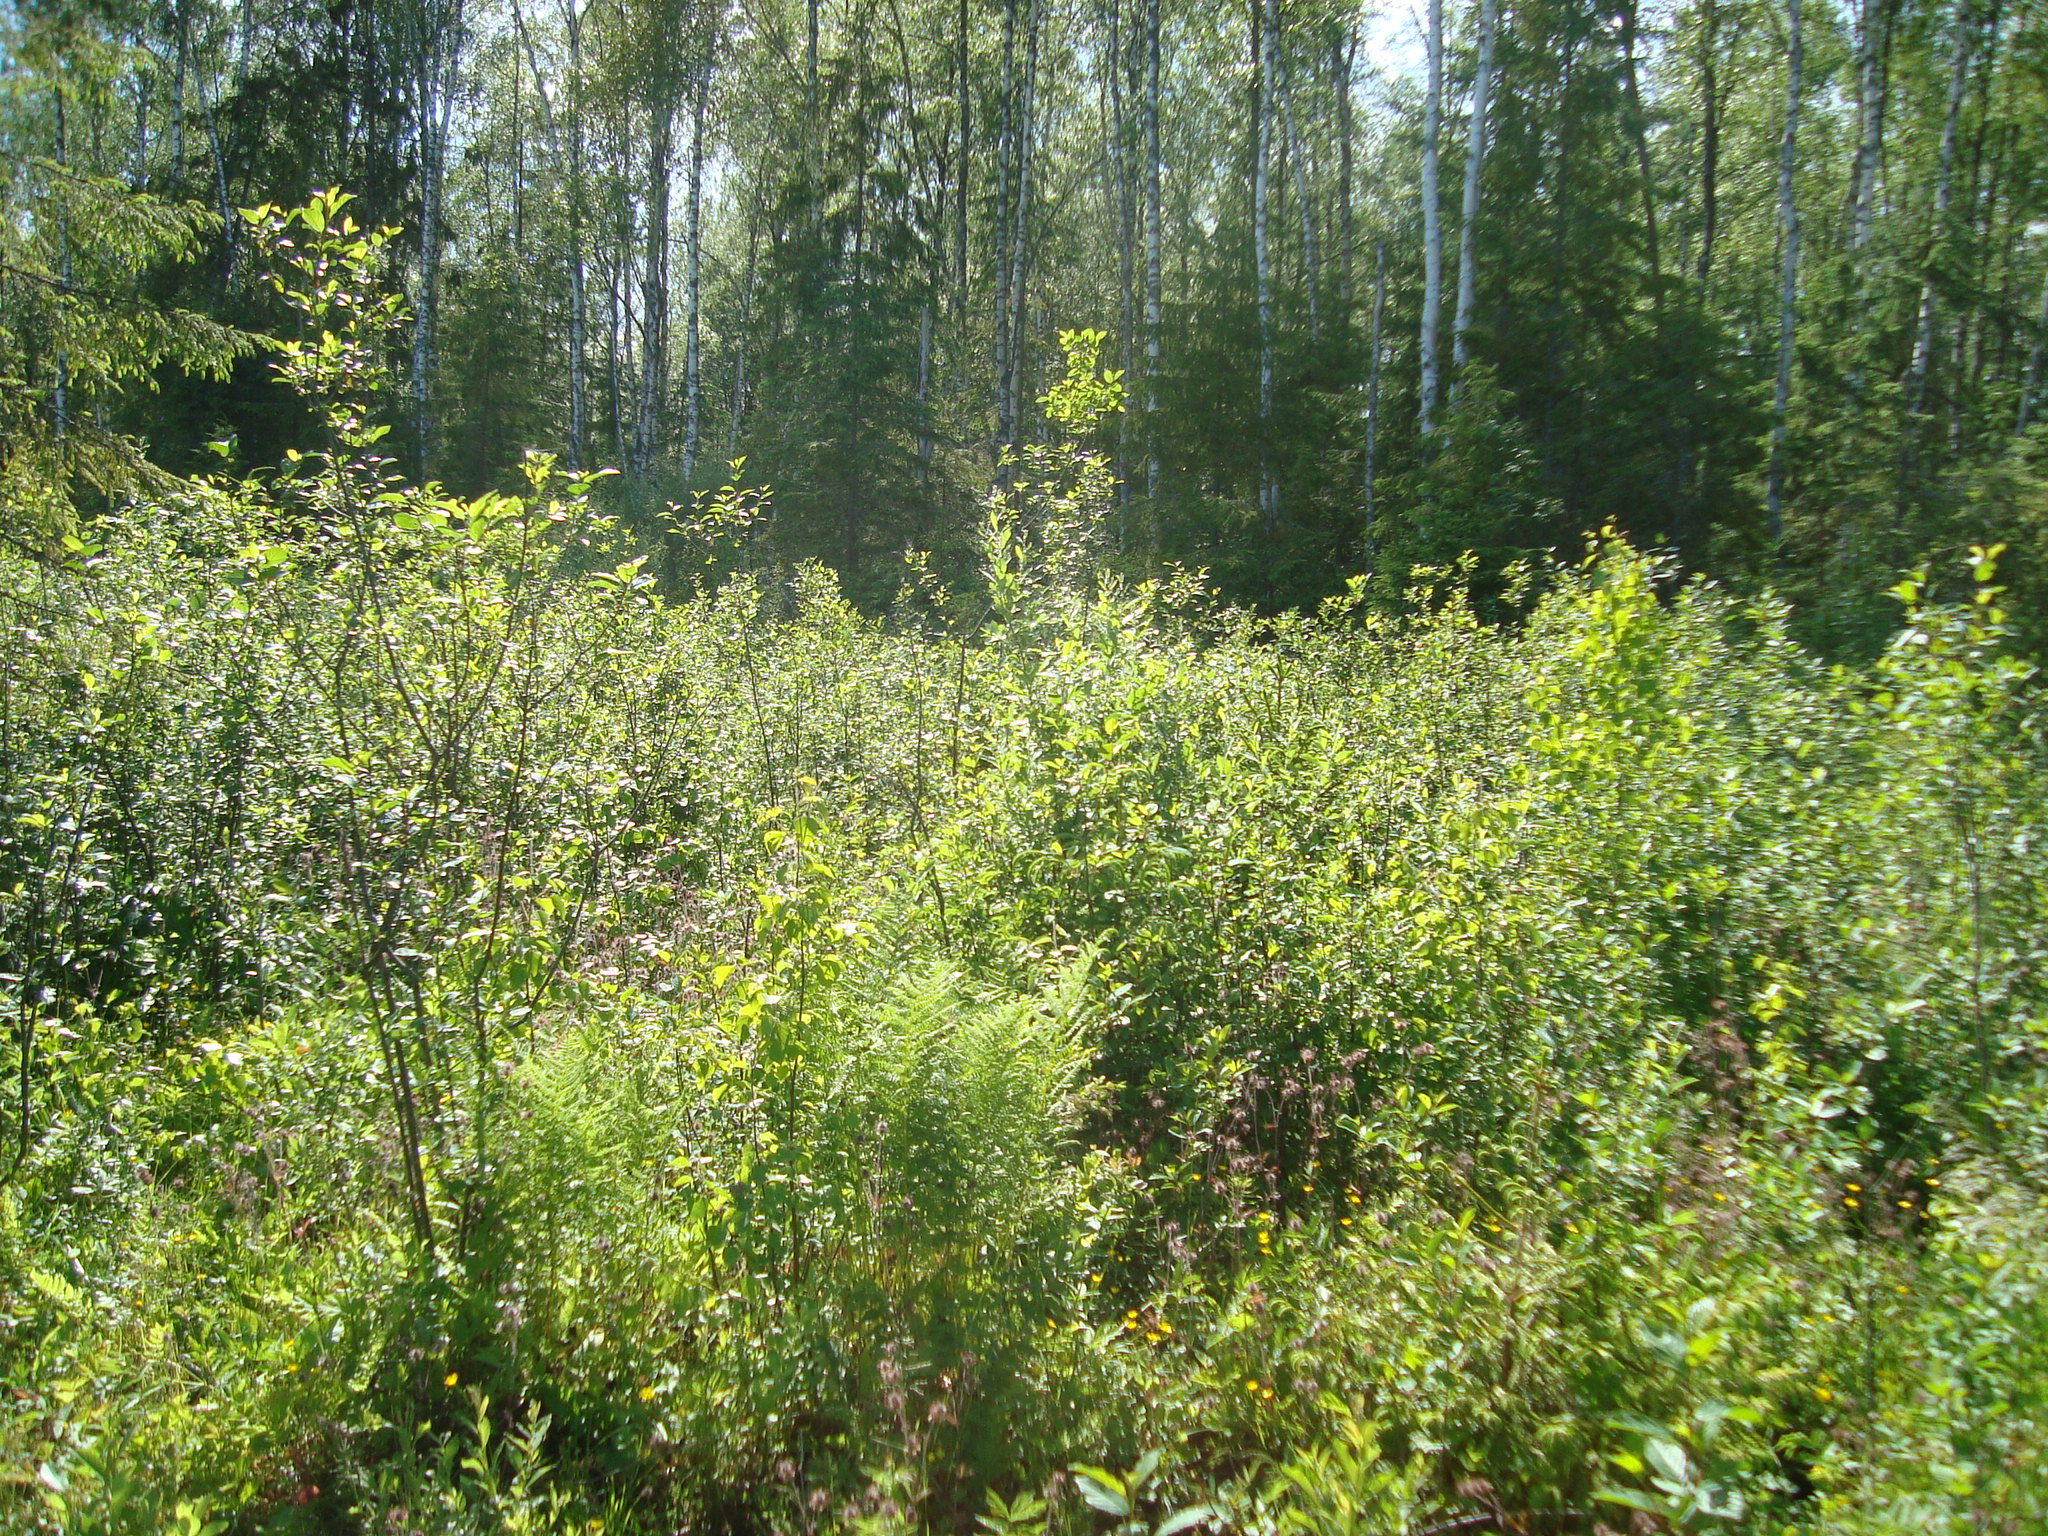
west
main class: Woodland
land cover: Spruce dominated mixed woodland
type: hemiboreal forest and nemoral coniferous forest and mixed broadleaved-coniferous forest
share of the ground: > 75 %
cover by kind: broadleaved forest trees 50 %, coniferous forest trees 30 %, shrubs 15 %, herbaceous plants 5 %
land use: Forestry
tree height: < 5 m
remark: Clear cut
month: June
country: LV
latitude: 56.6585
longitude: 25.7377
